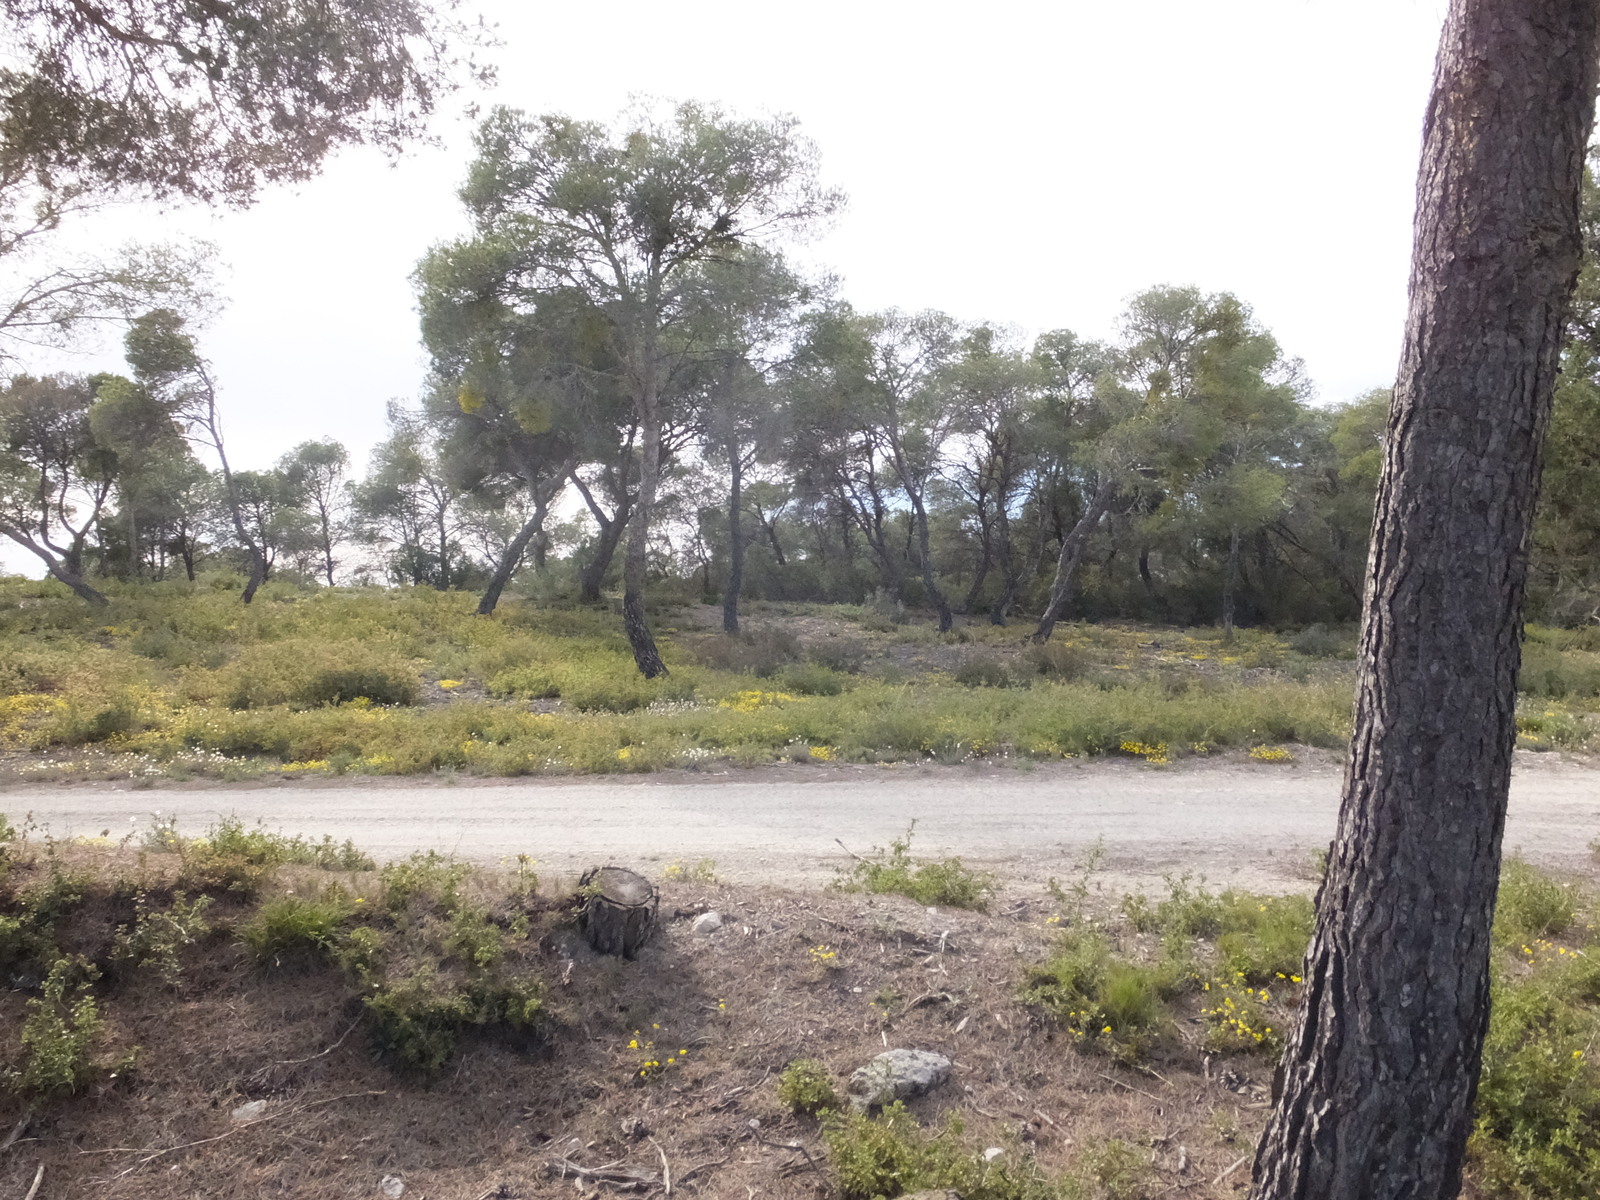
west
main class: Woodland
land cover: Pine dominated coniferous woodland
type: coniferous forest of the mediterranean region
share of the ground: 50 - 75 %
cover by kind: coniferous forest trees 70 %, broadleaved forest trees 15 %, shrubs 10 %, herbaceous plants 5 %
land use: Forestry
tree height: > 5 m
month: April
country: ES
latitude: 41.6153
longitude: -0.3262
